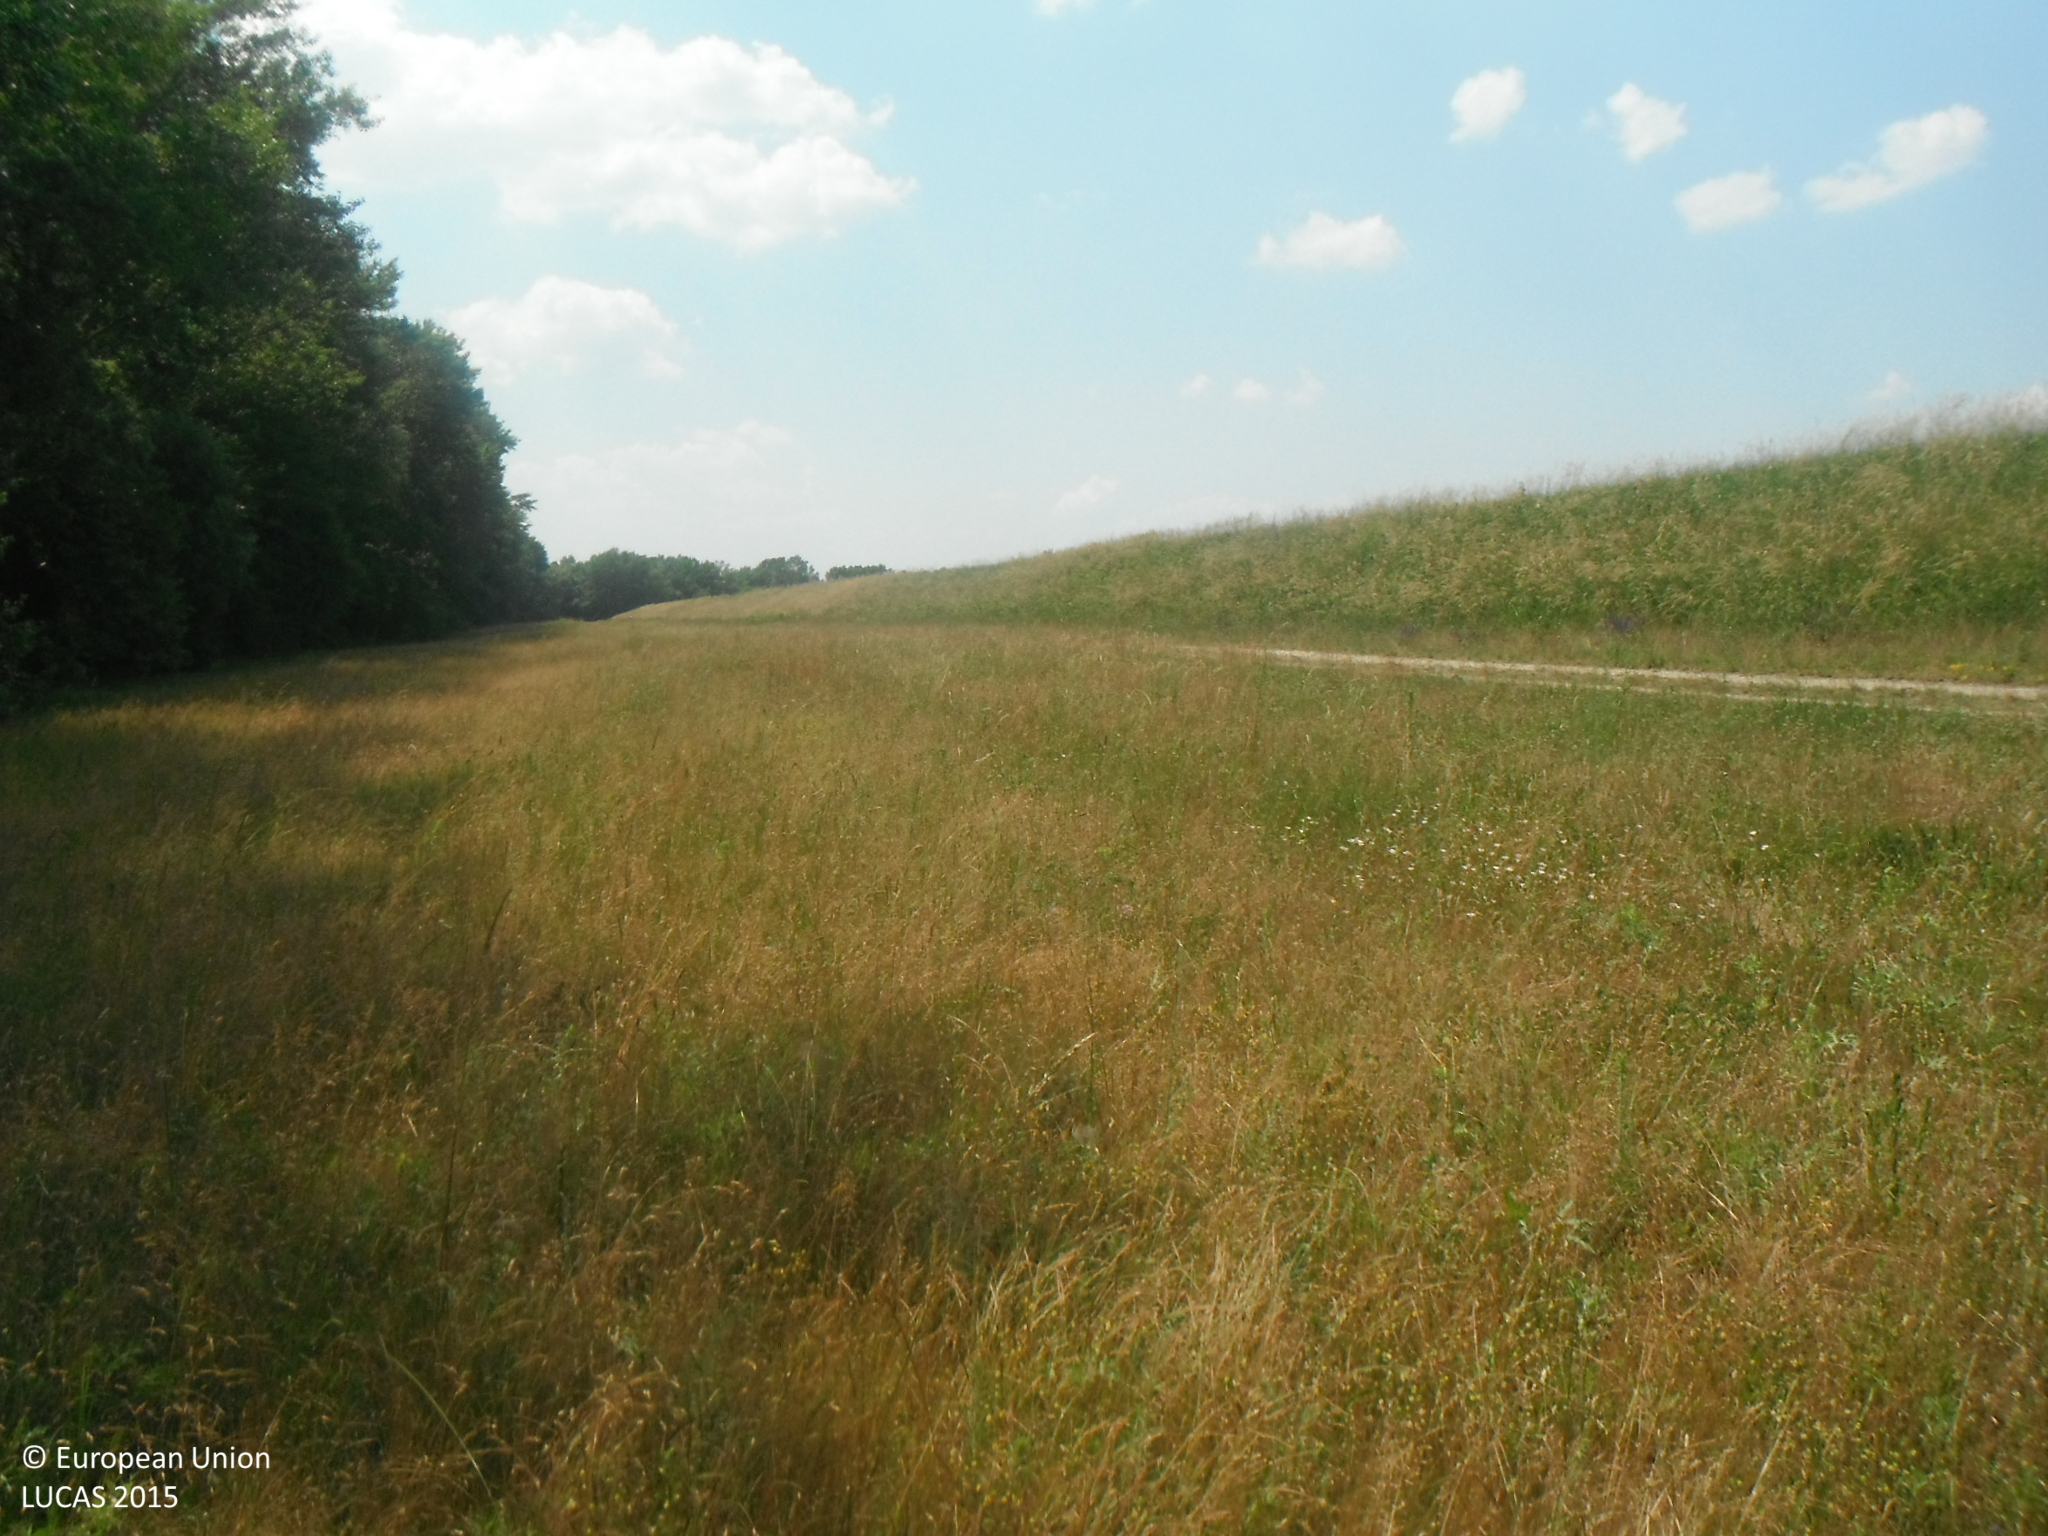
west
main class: Grassland
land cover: Grassland without tree/shrub cover
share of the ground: > 75 %
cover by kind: herbaceous plants 100 %
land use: Agriculture (excluding fallow land and kitchen gardens)
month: June
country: SK
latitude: 47.7516
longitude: 18.0015
